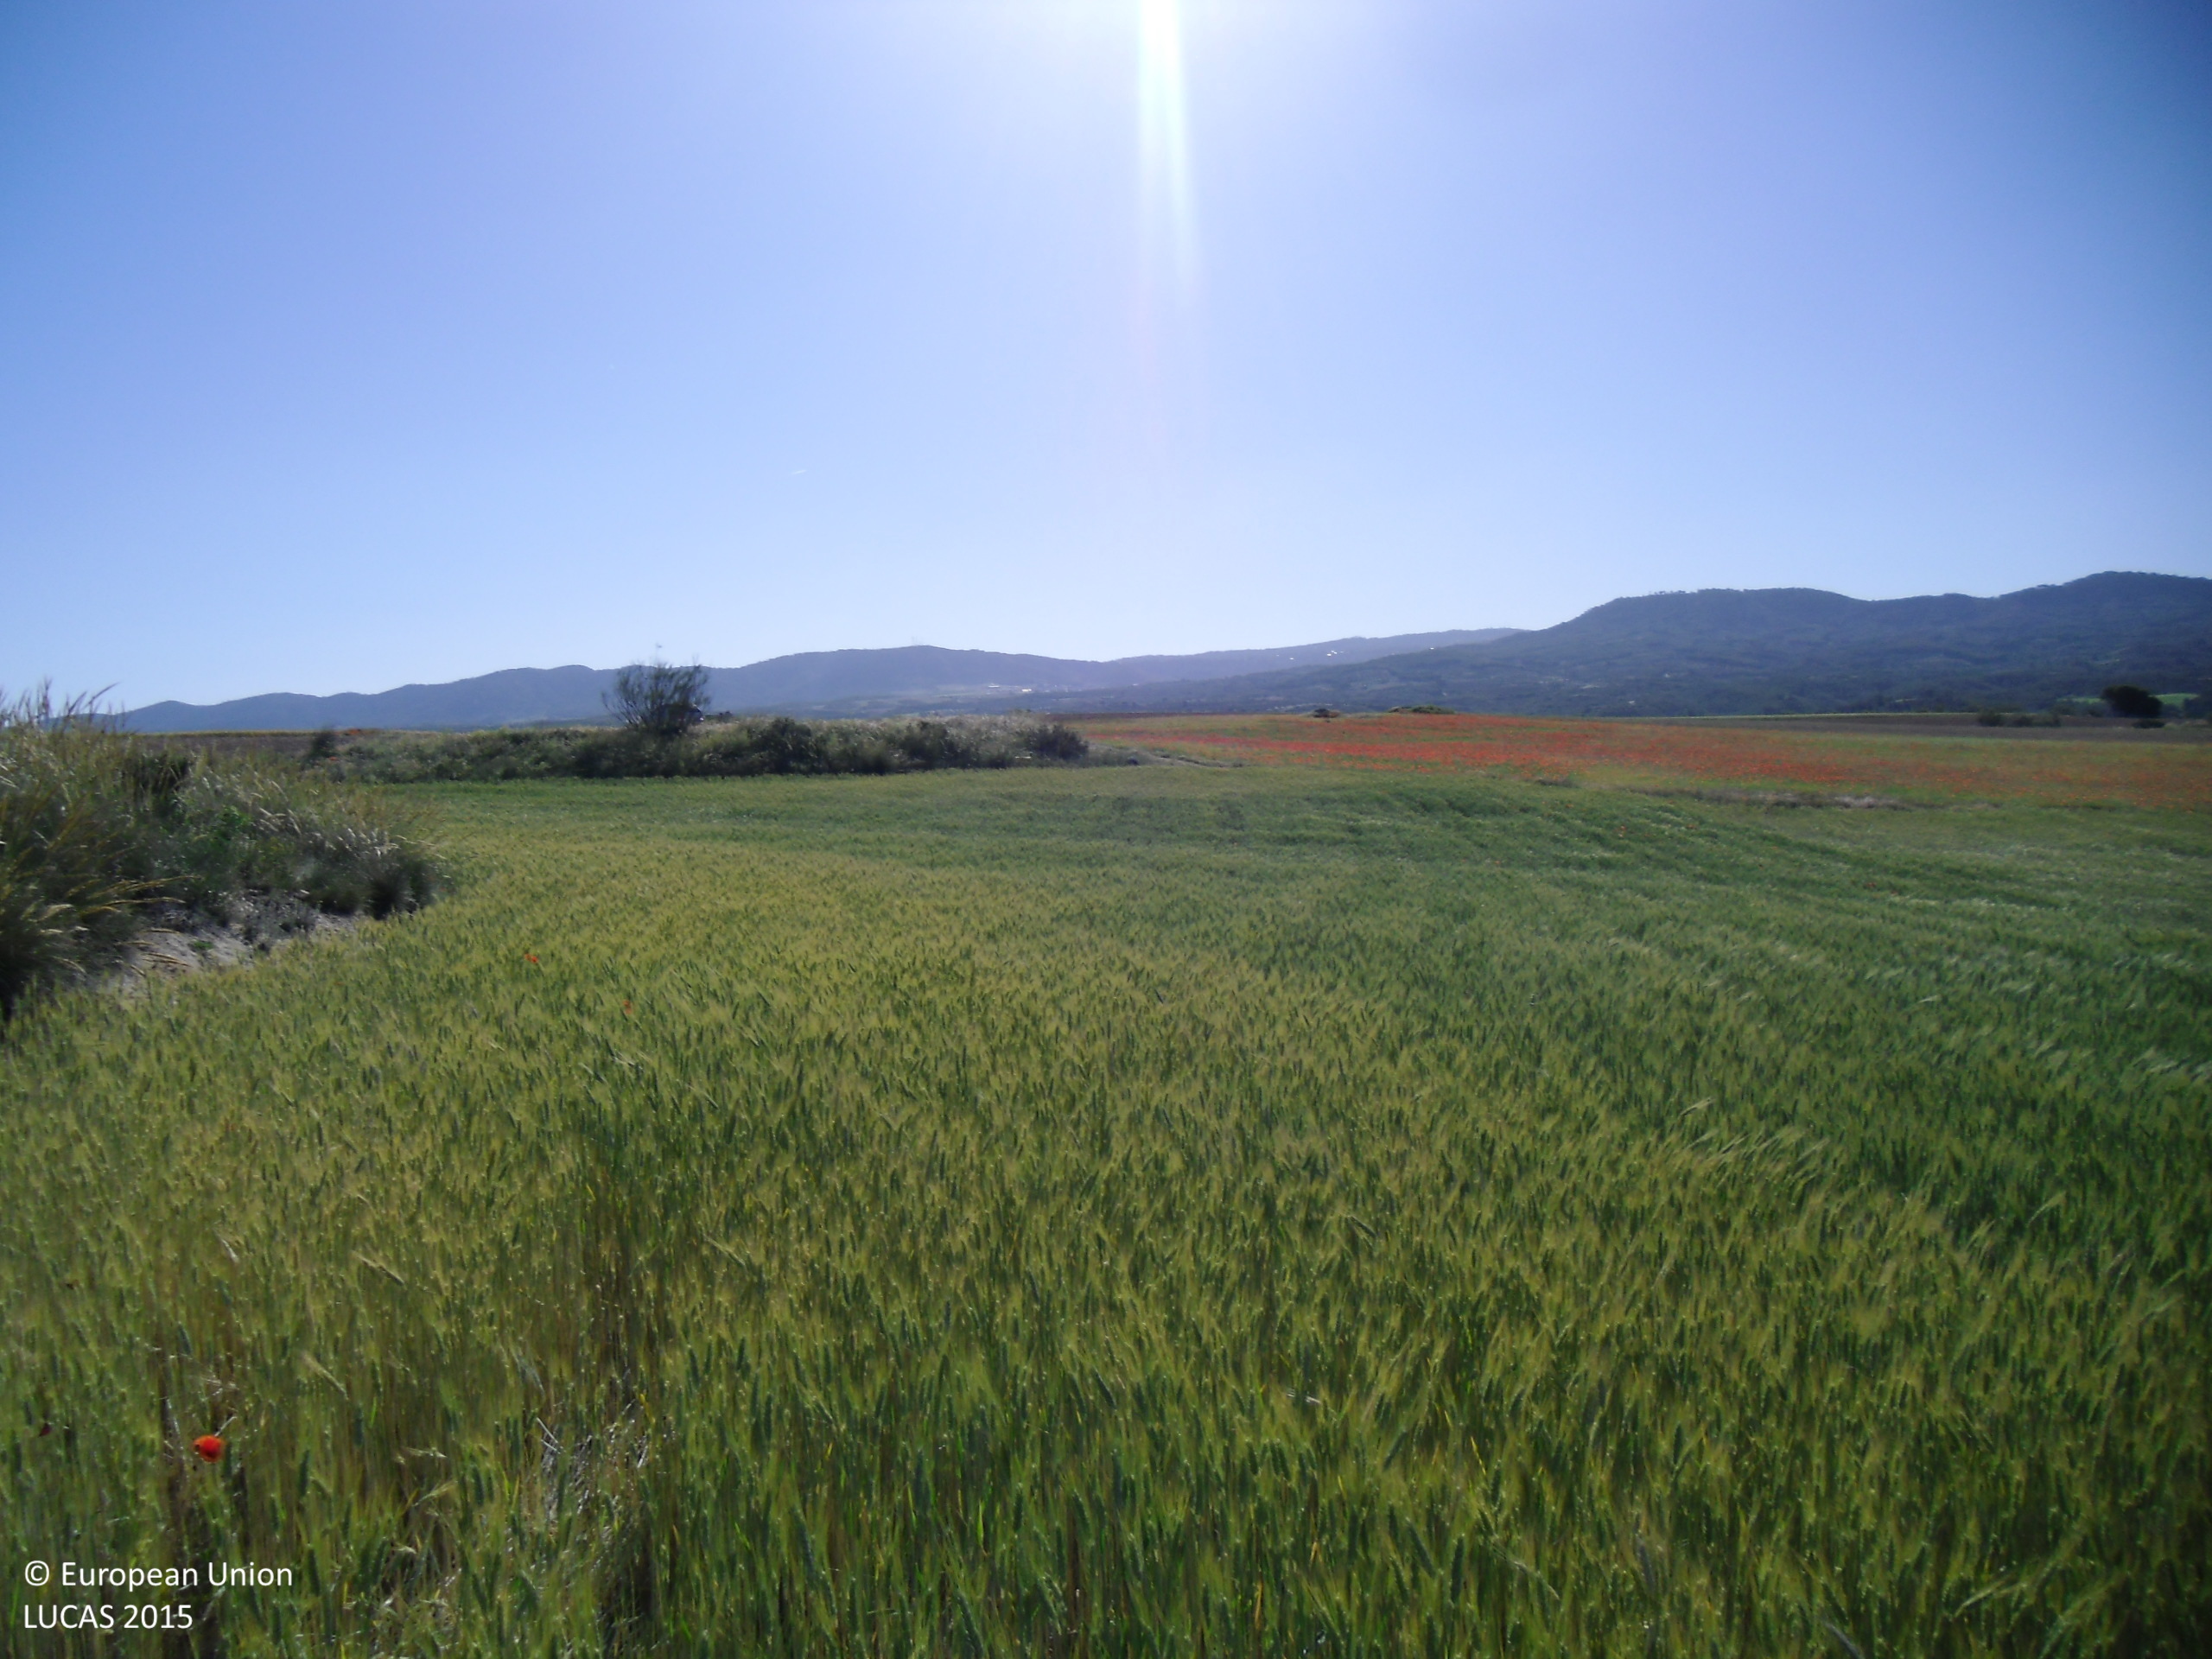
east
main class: Shrubland
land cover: Shrubland without tree cover
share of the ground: 25 - 50 %
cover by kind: herbaceous plants 70 %, shrubs 30 %
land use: Semi-natural and natural areas not in use
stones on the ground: < 10 %
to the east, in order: Shrubland without tree cover; Grassland without tree/shrub cover; Barley; Shrubland without tree cover; Barley; Tracks; Dry pulses; Other bare soil
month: May
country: ES
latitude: 40.3069
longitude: -2.9103
